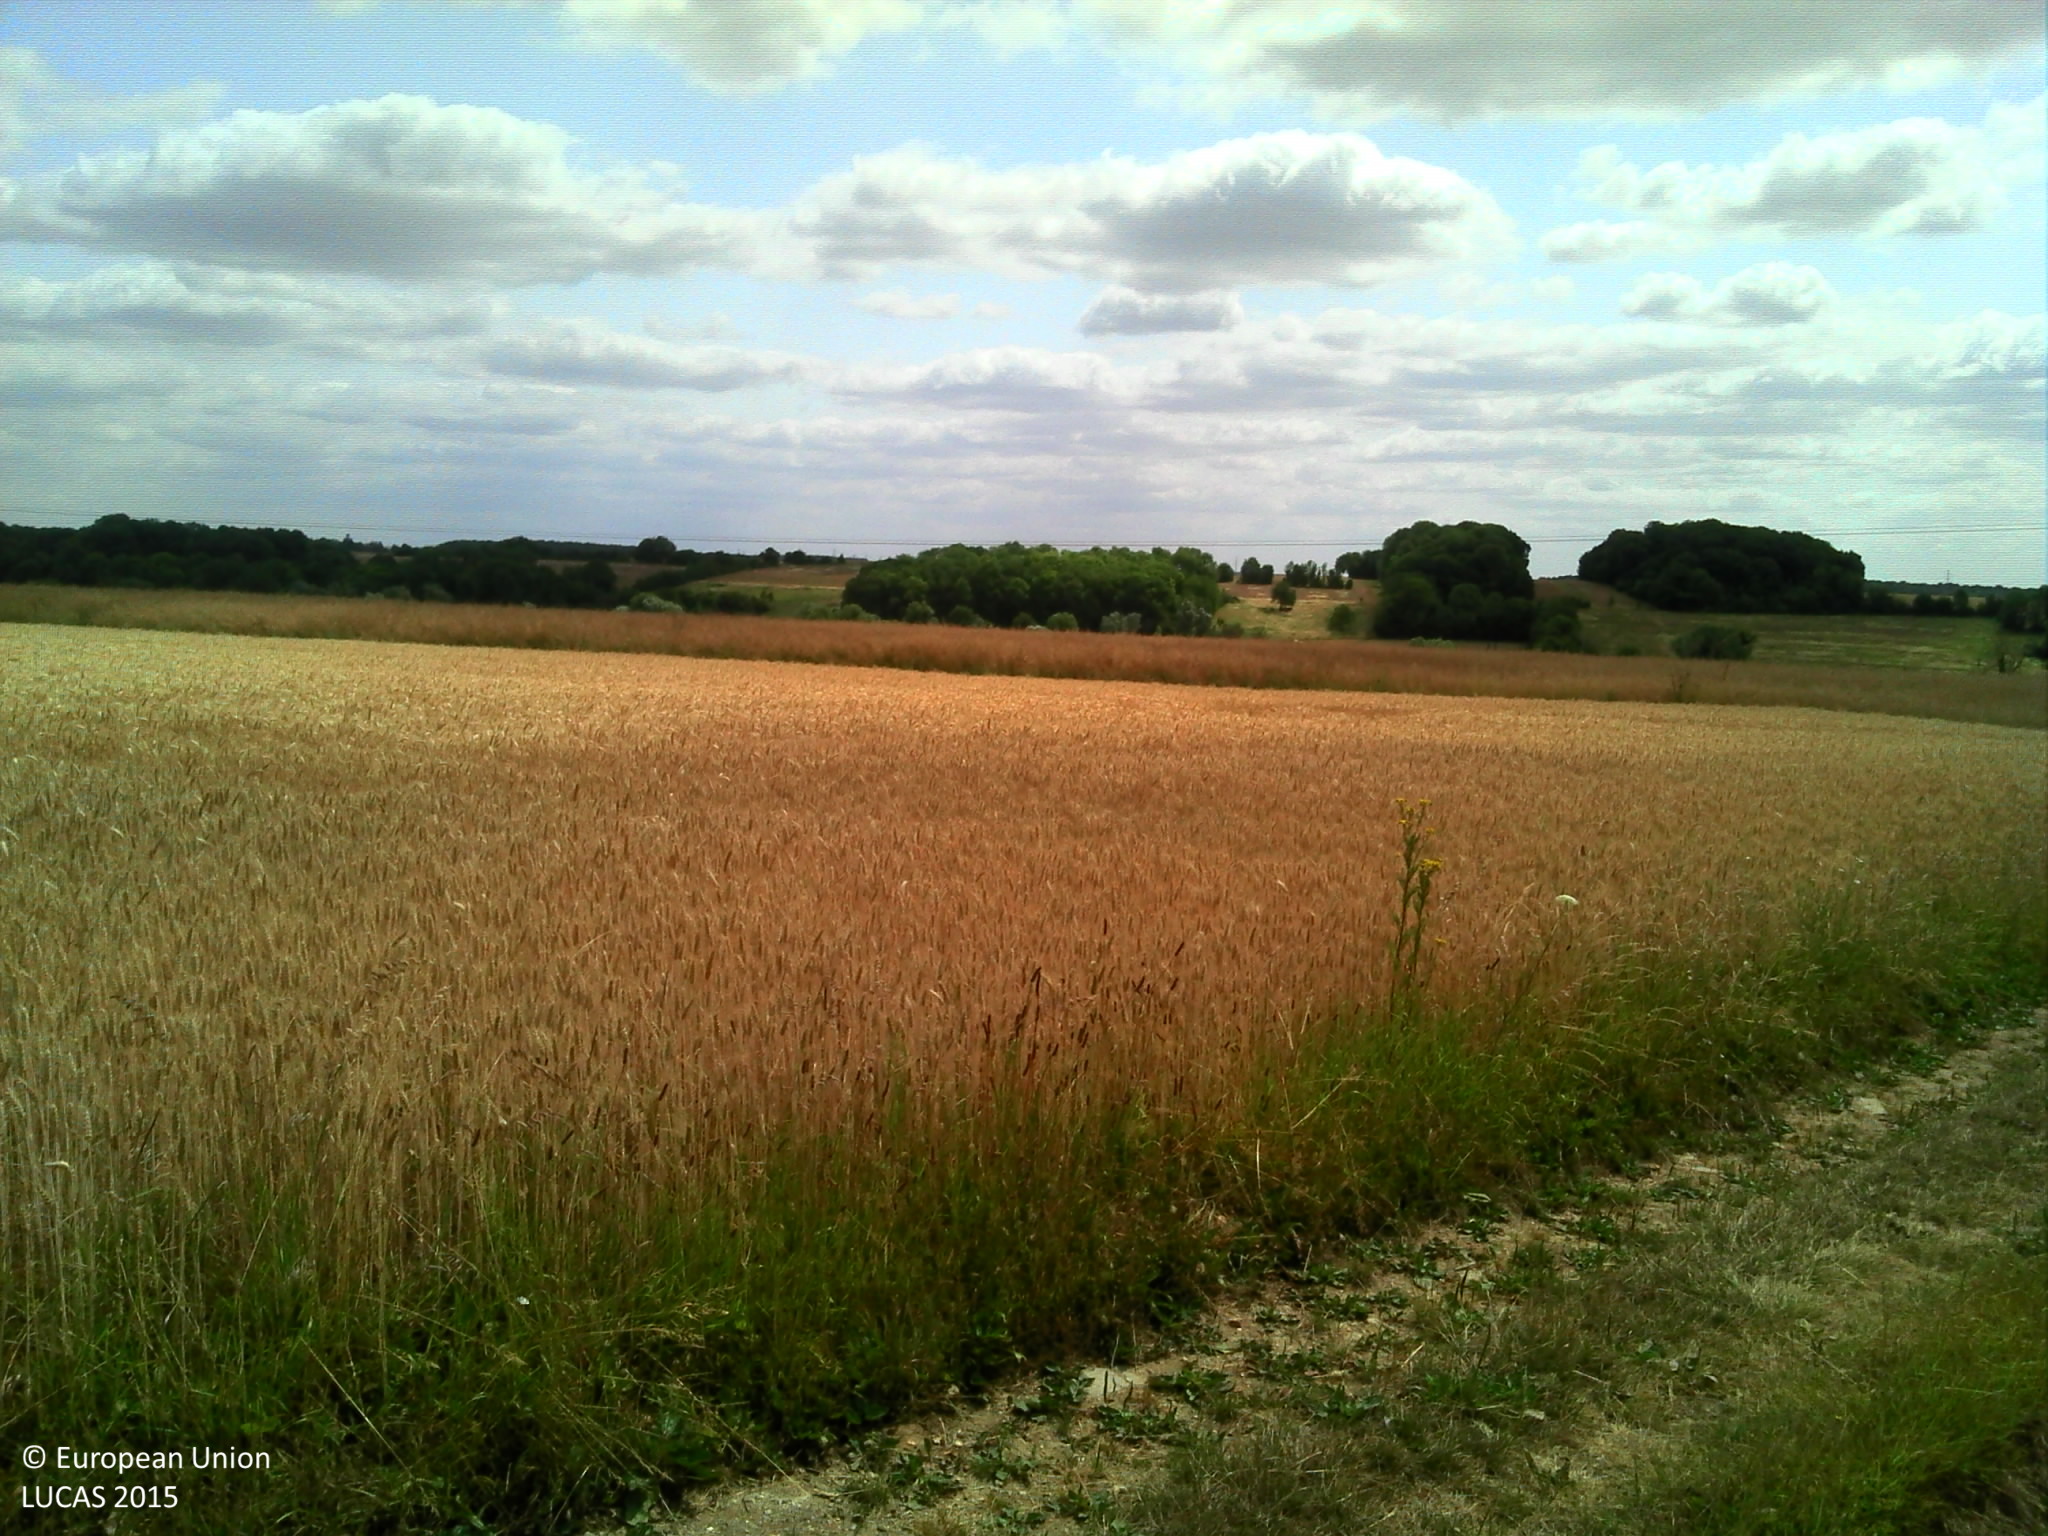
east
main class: Cropland
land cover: Rape and turnip rape
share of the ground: > 75 %
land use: Agriculture (excluding fallow land and kitchen gardens)
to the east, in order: Rape and turnip rape; Electric lines; Rape and turnip rape; Grass margins; Tracks; Grass margins; Common wheat; Grass margins; Rape and turnip rape; Electric lines; Rape and turnip rape
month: July
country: FR
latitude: 49.2942
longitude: 1.8302
